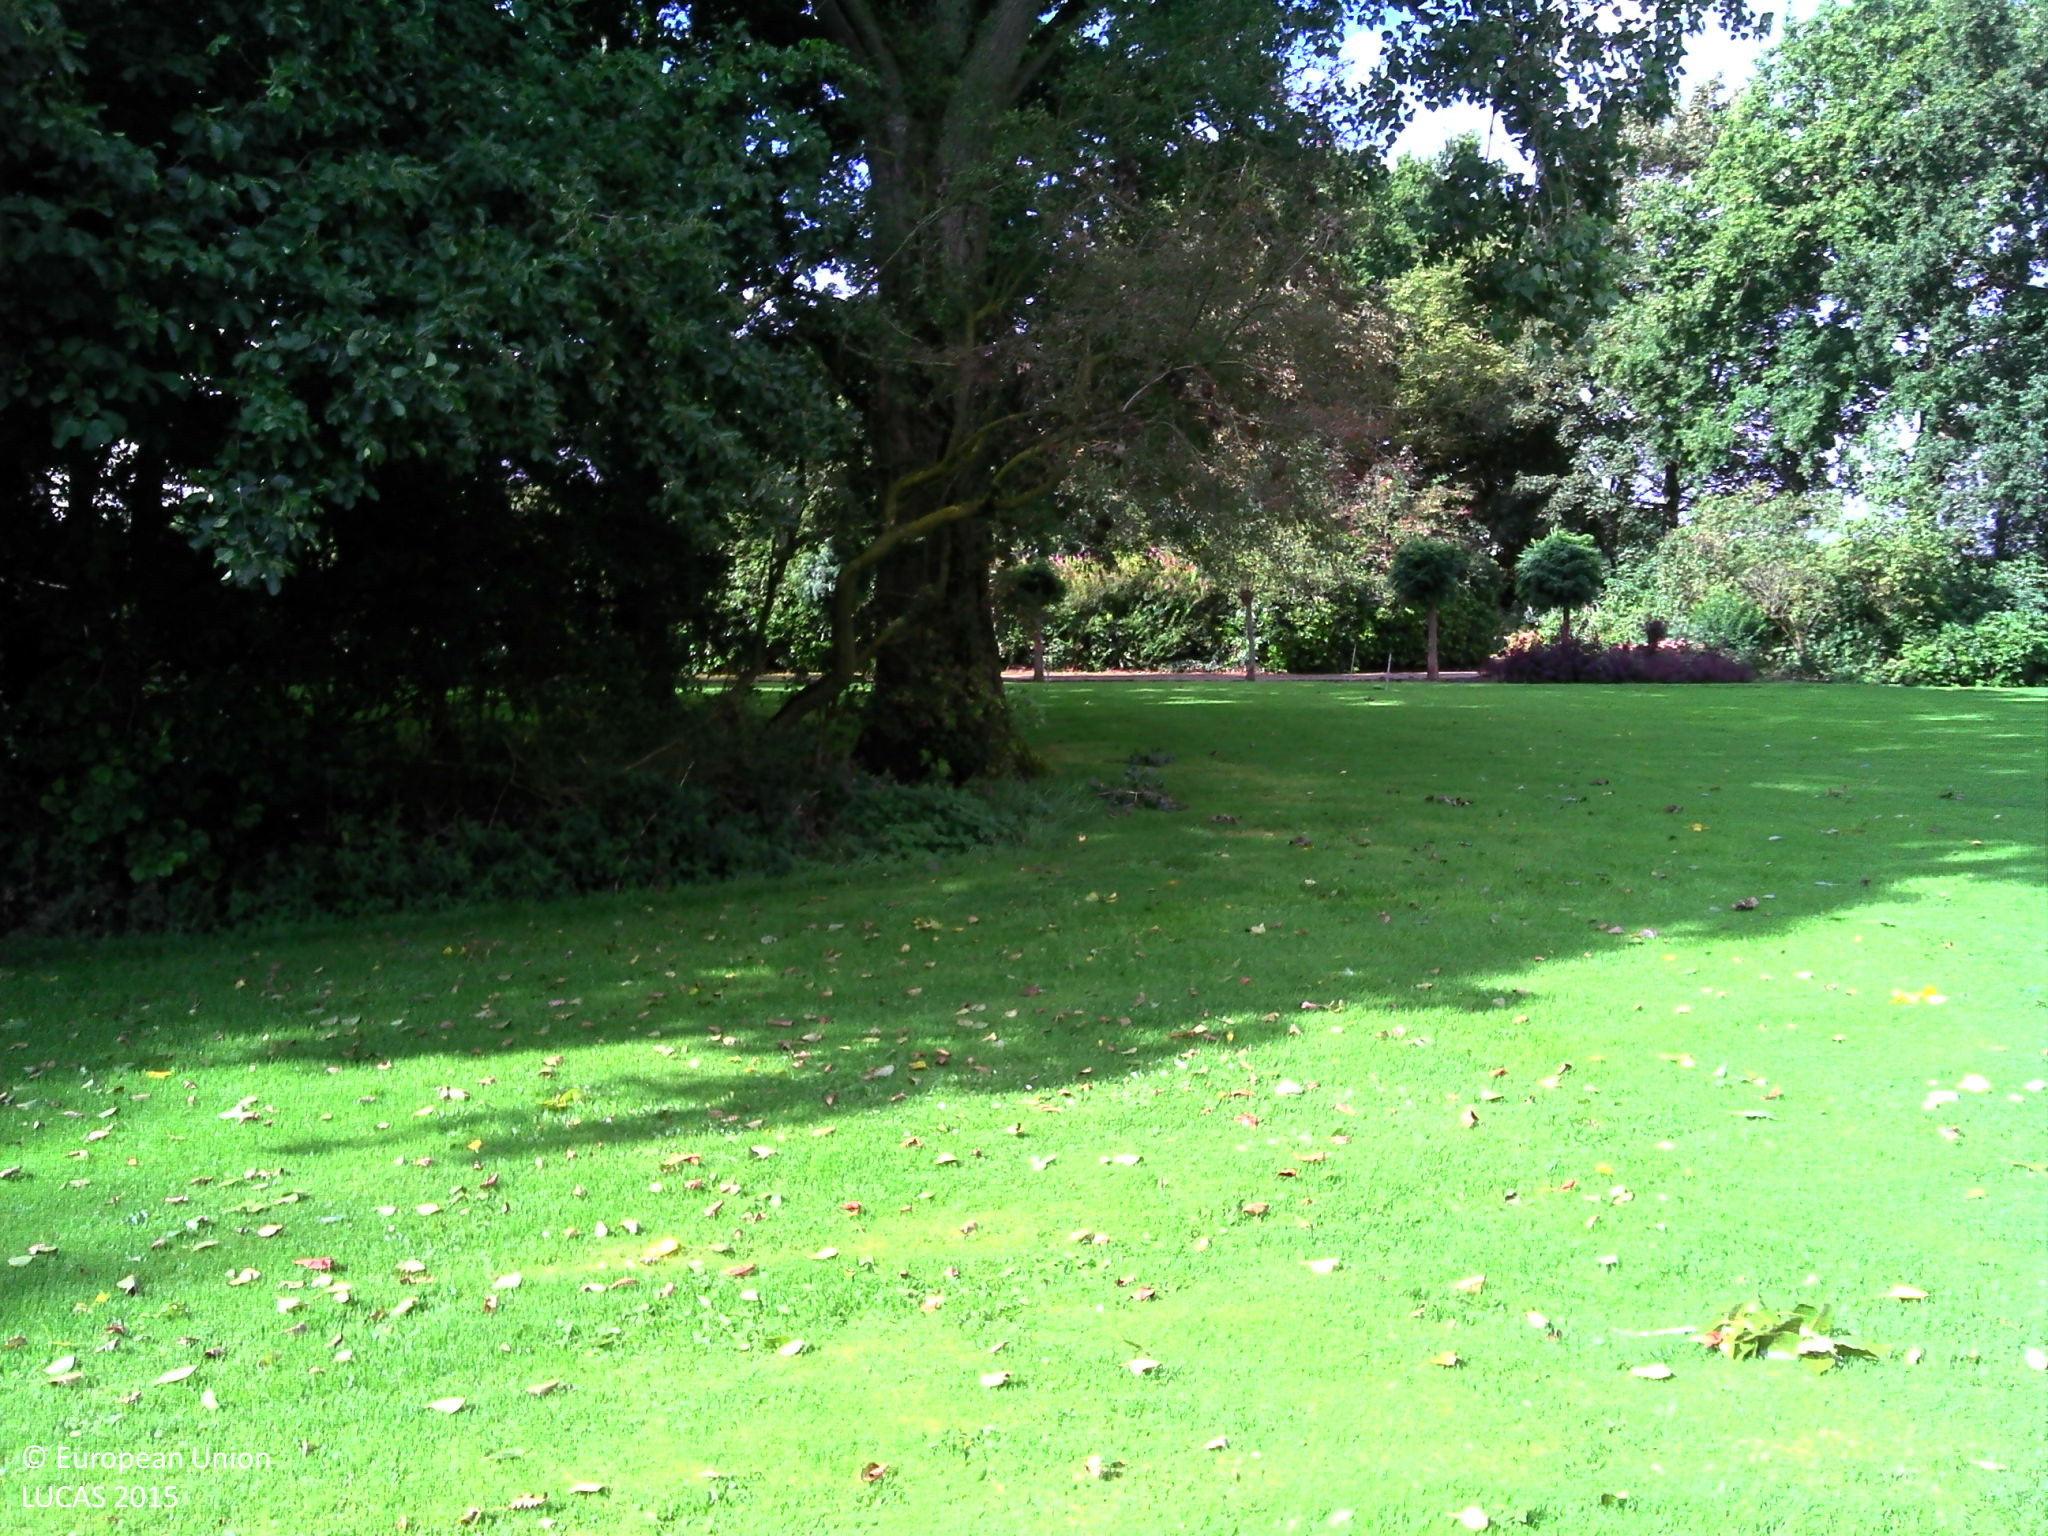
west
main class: Grassland
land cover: Grassland without tree/shrub cover
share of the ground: > 75 %
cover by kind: herbaceous plants 100 %
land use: Residential
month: September
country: BE
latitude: 51.4744
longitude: 4.4815
